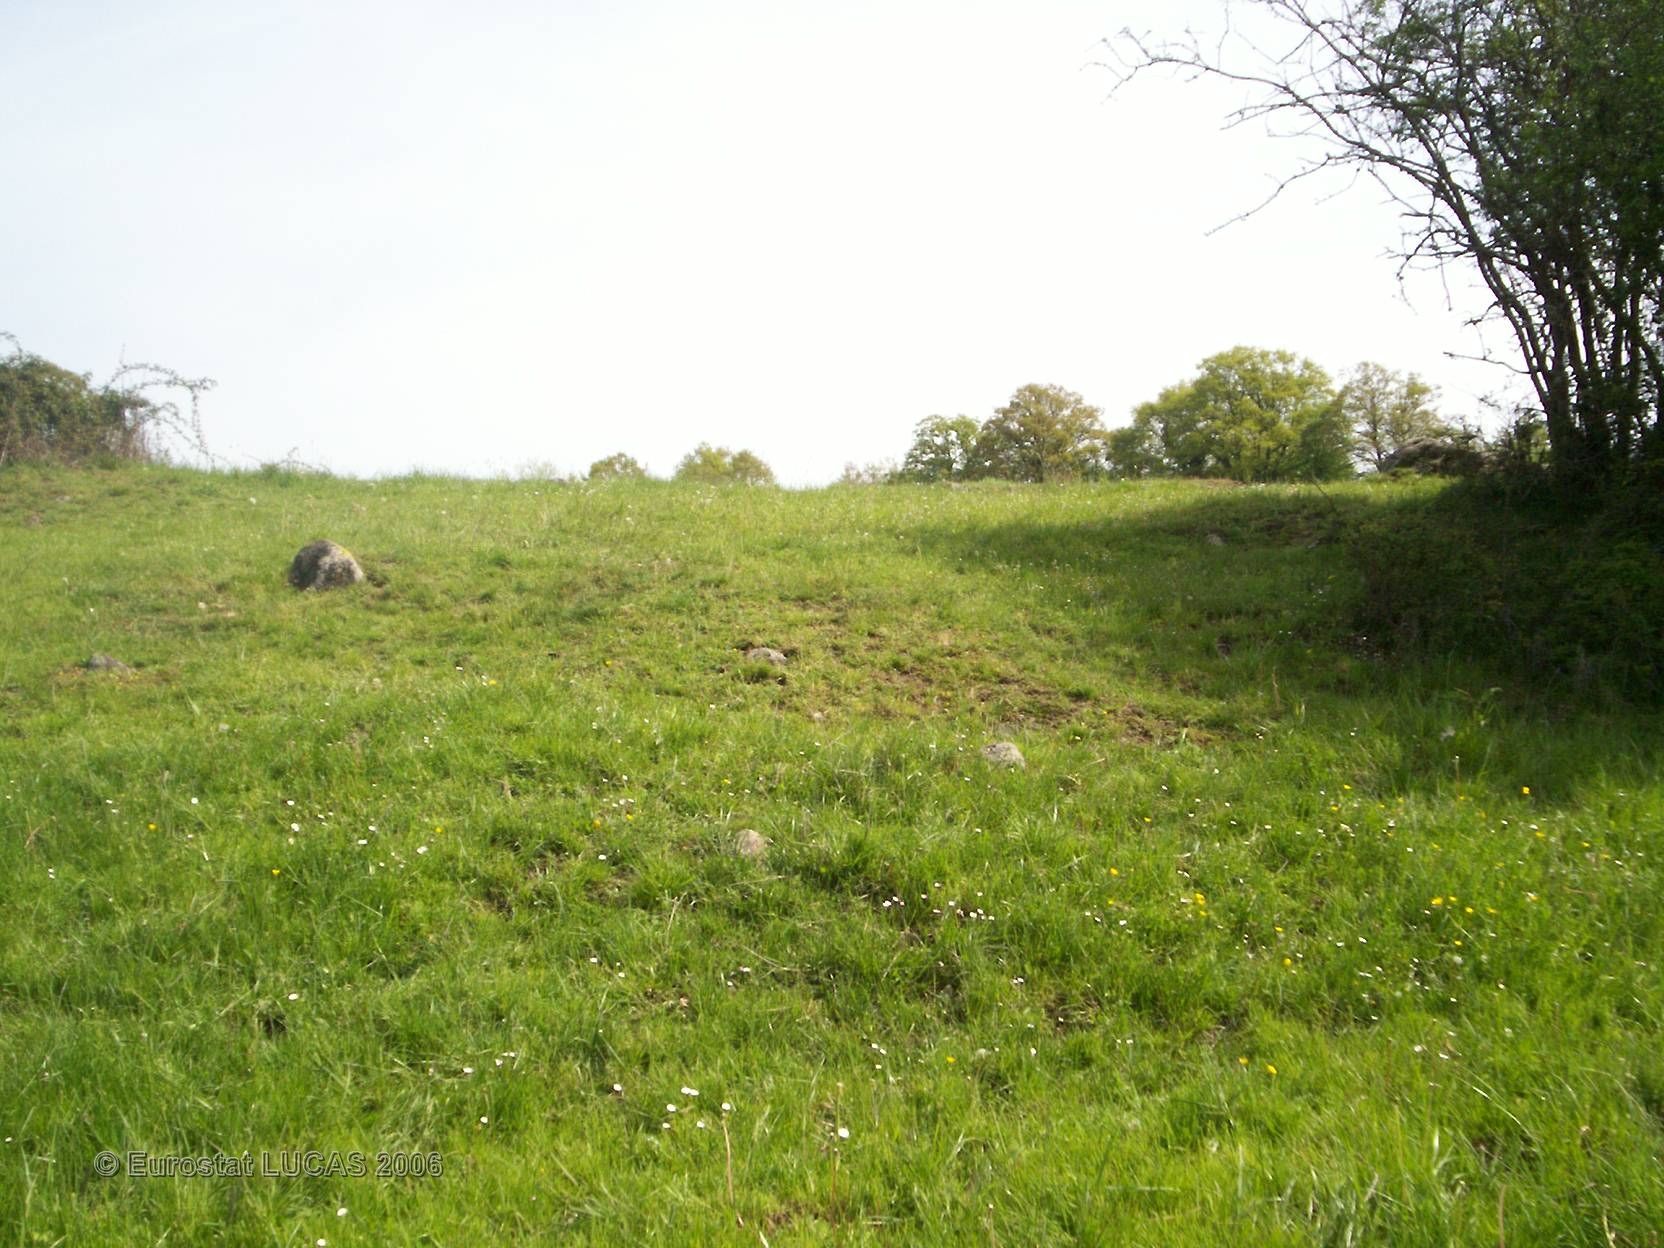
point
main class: Grassland
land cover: Grassland without tree/shrub cover
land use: Agriculture (excluding fallow land and kitchen gardens)
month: May
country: FR
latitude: 46.3859
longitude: 3.1715
